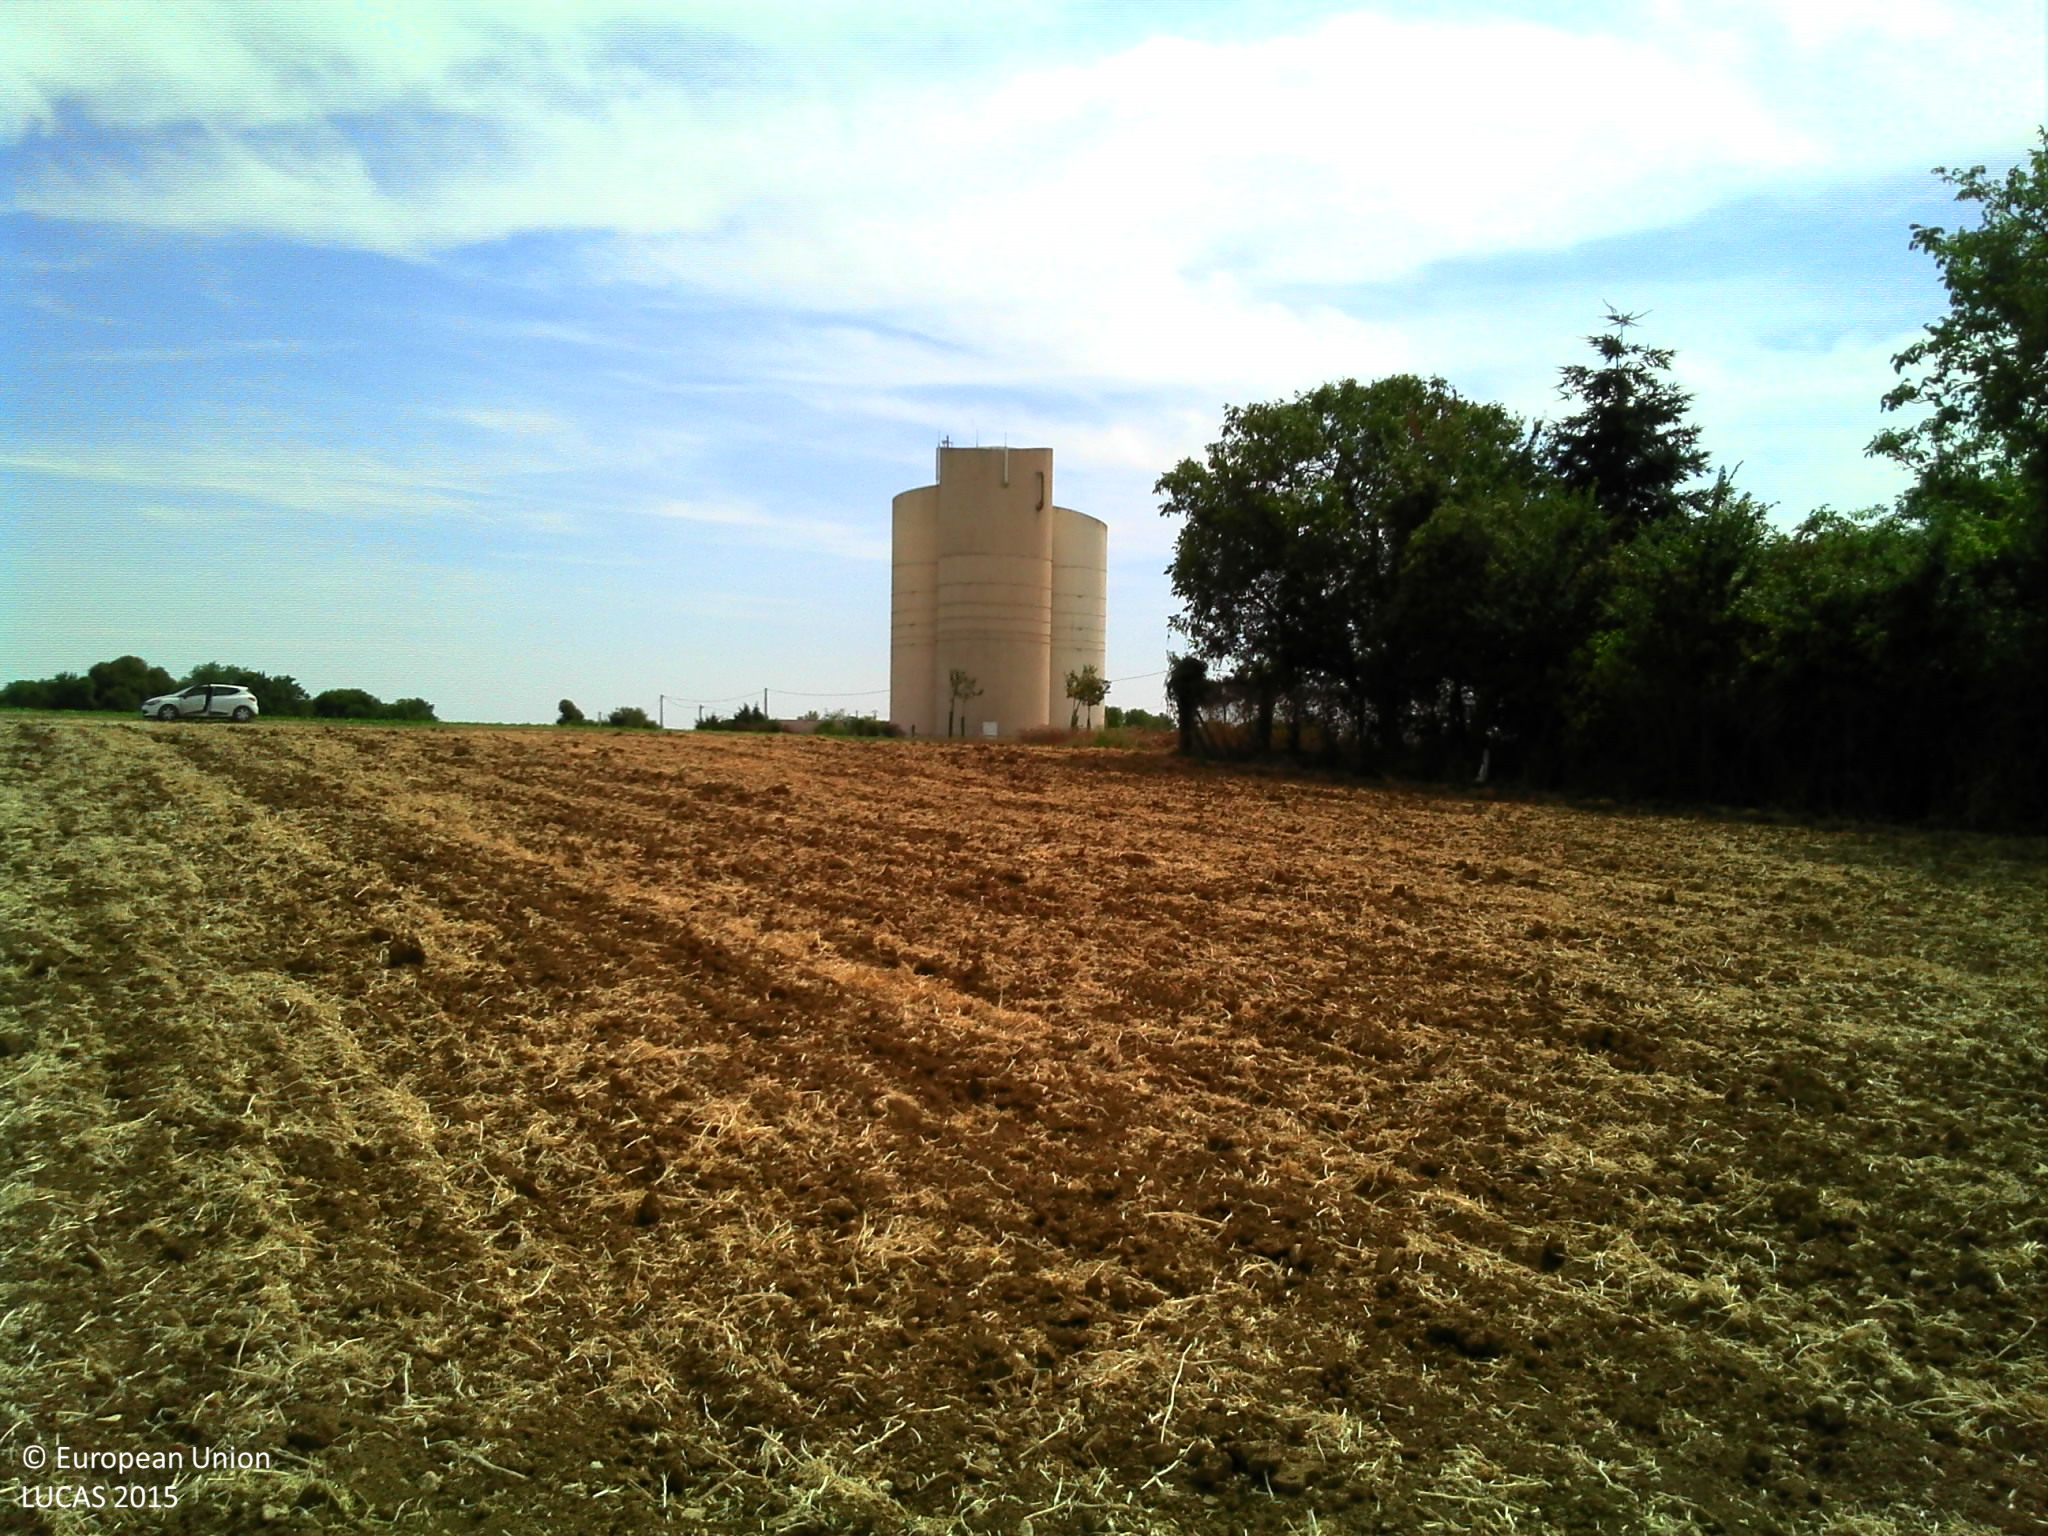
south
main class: Cropland
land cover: Dry pulses
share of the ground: > 75 %
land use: Agriculture (excluding fallow land and kitchen gardens)
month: August
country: FR
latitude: 48.2186
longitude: 2.4660
